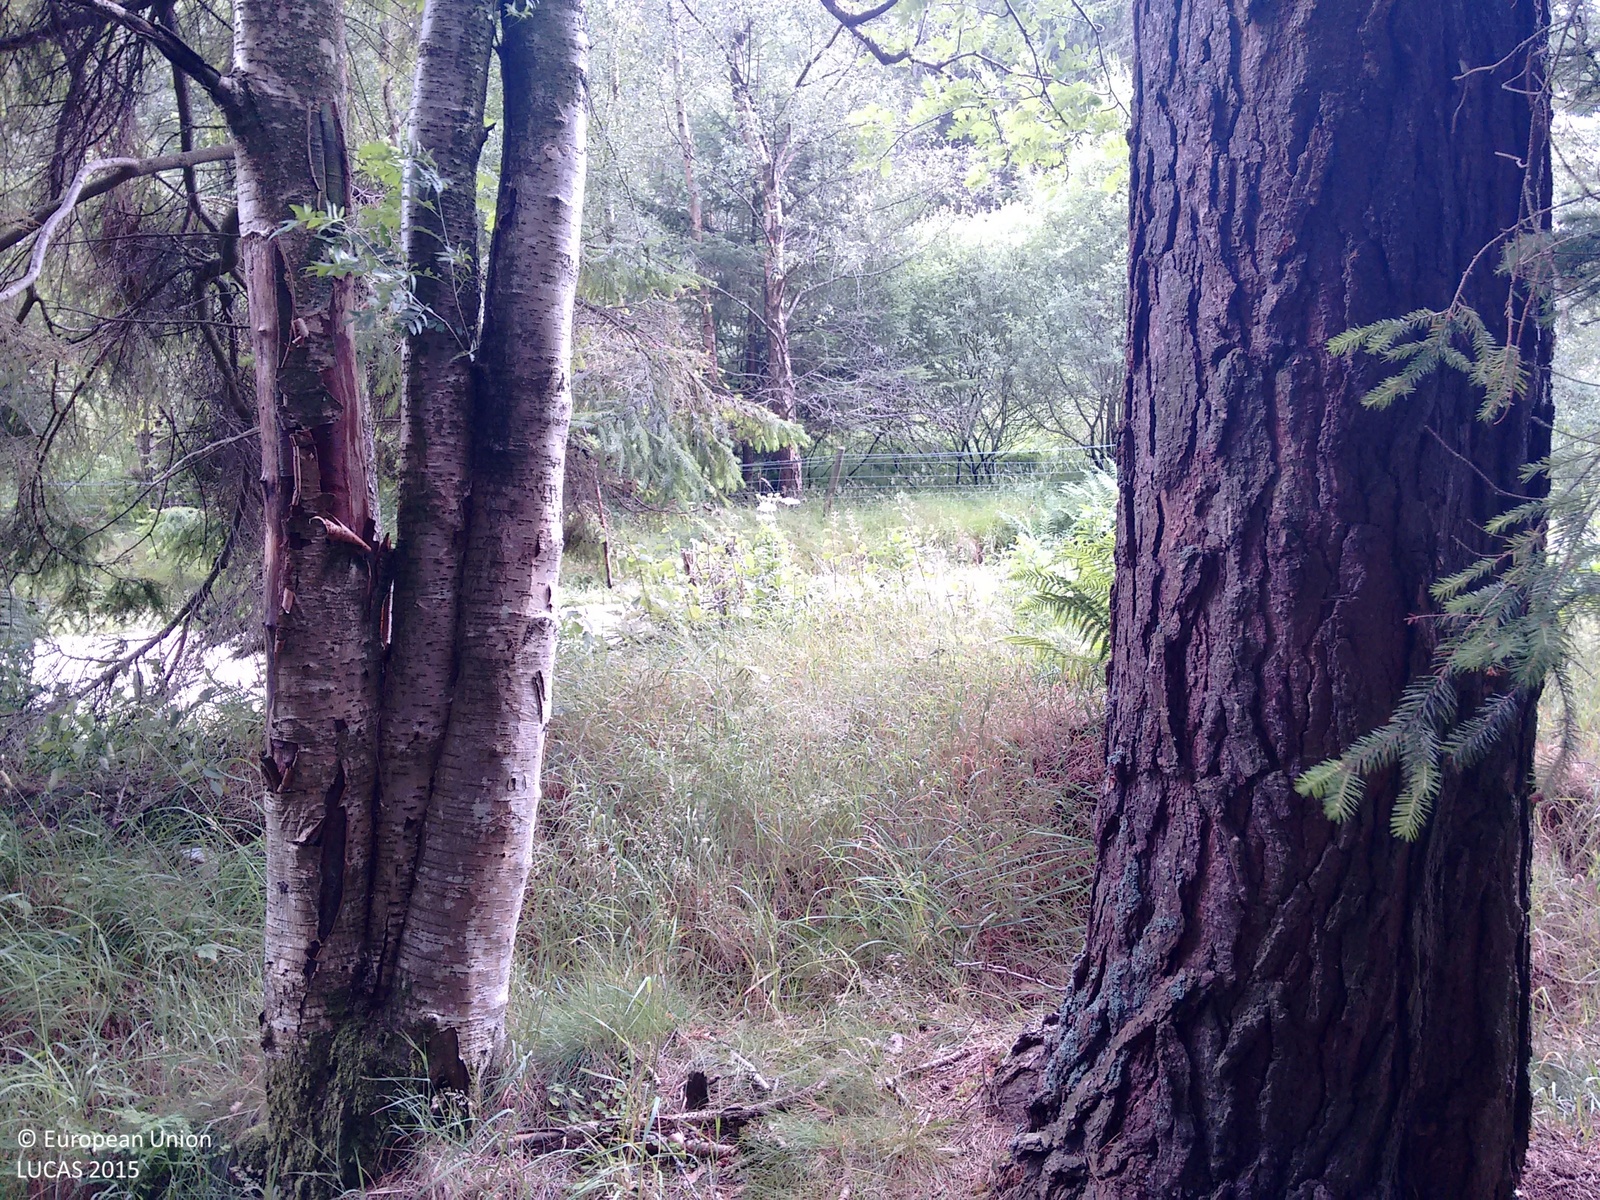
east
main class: Woodland
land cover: Spruce dominated mixed woodland
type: exotic forest
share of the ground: > 75 %
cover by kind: coniferous forest trees 65 %, broadleaved forest trees 25 %, consolidated bare surface 10 %
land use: Forestry
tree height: > 5 m
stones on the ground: < 10 %
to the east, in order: Spruce dominated mixed woodland; Paved roads, cycling and walking lanes; Ditches and canals; Fences; Spruce dominated coniferous woodland; Pine dominated coniferous woodland; Other coniferous woodland
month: August
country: GB
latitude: 57.3488
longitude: -3.3465
